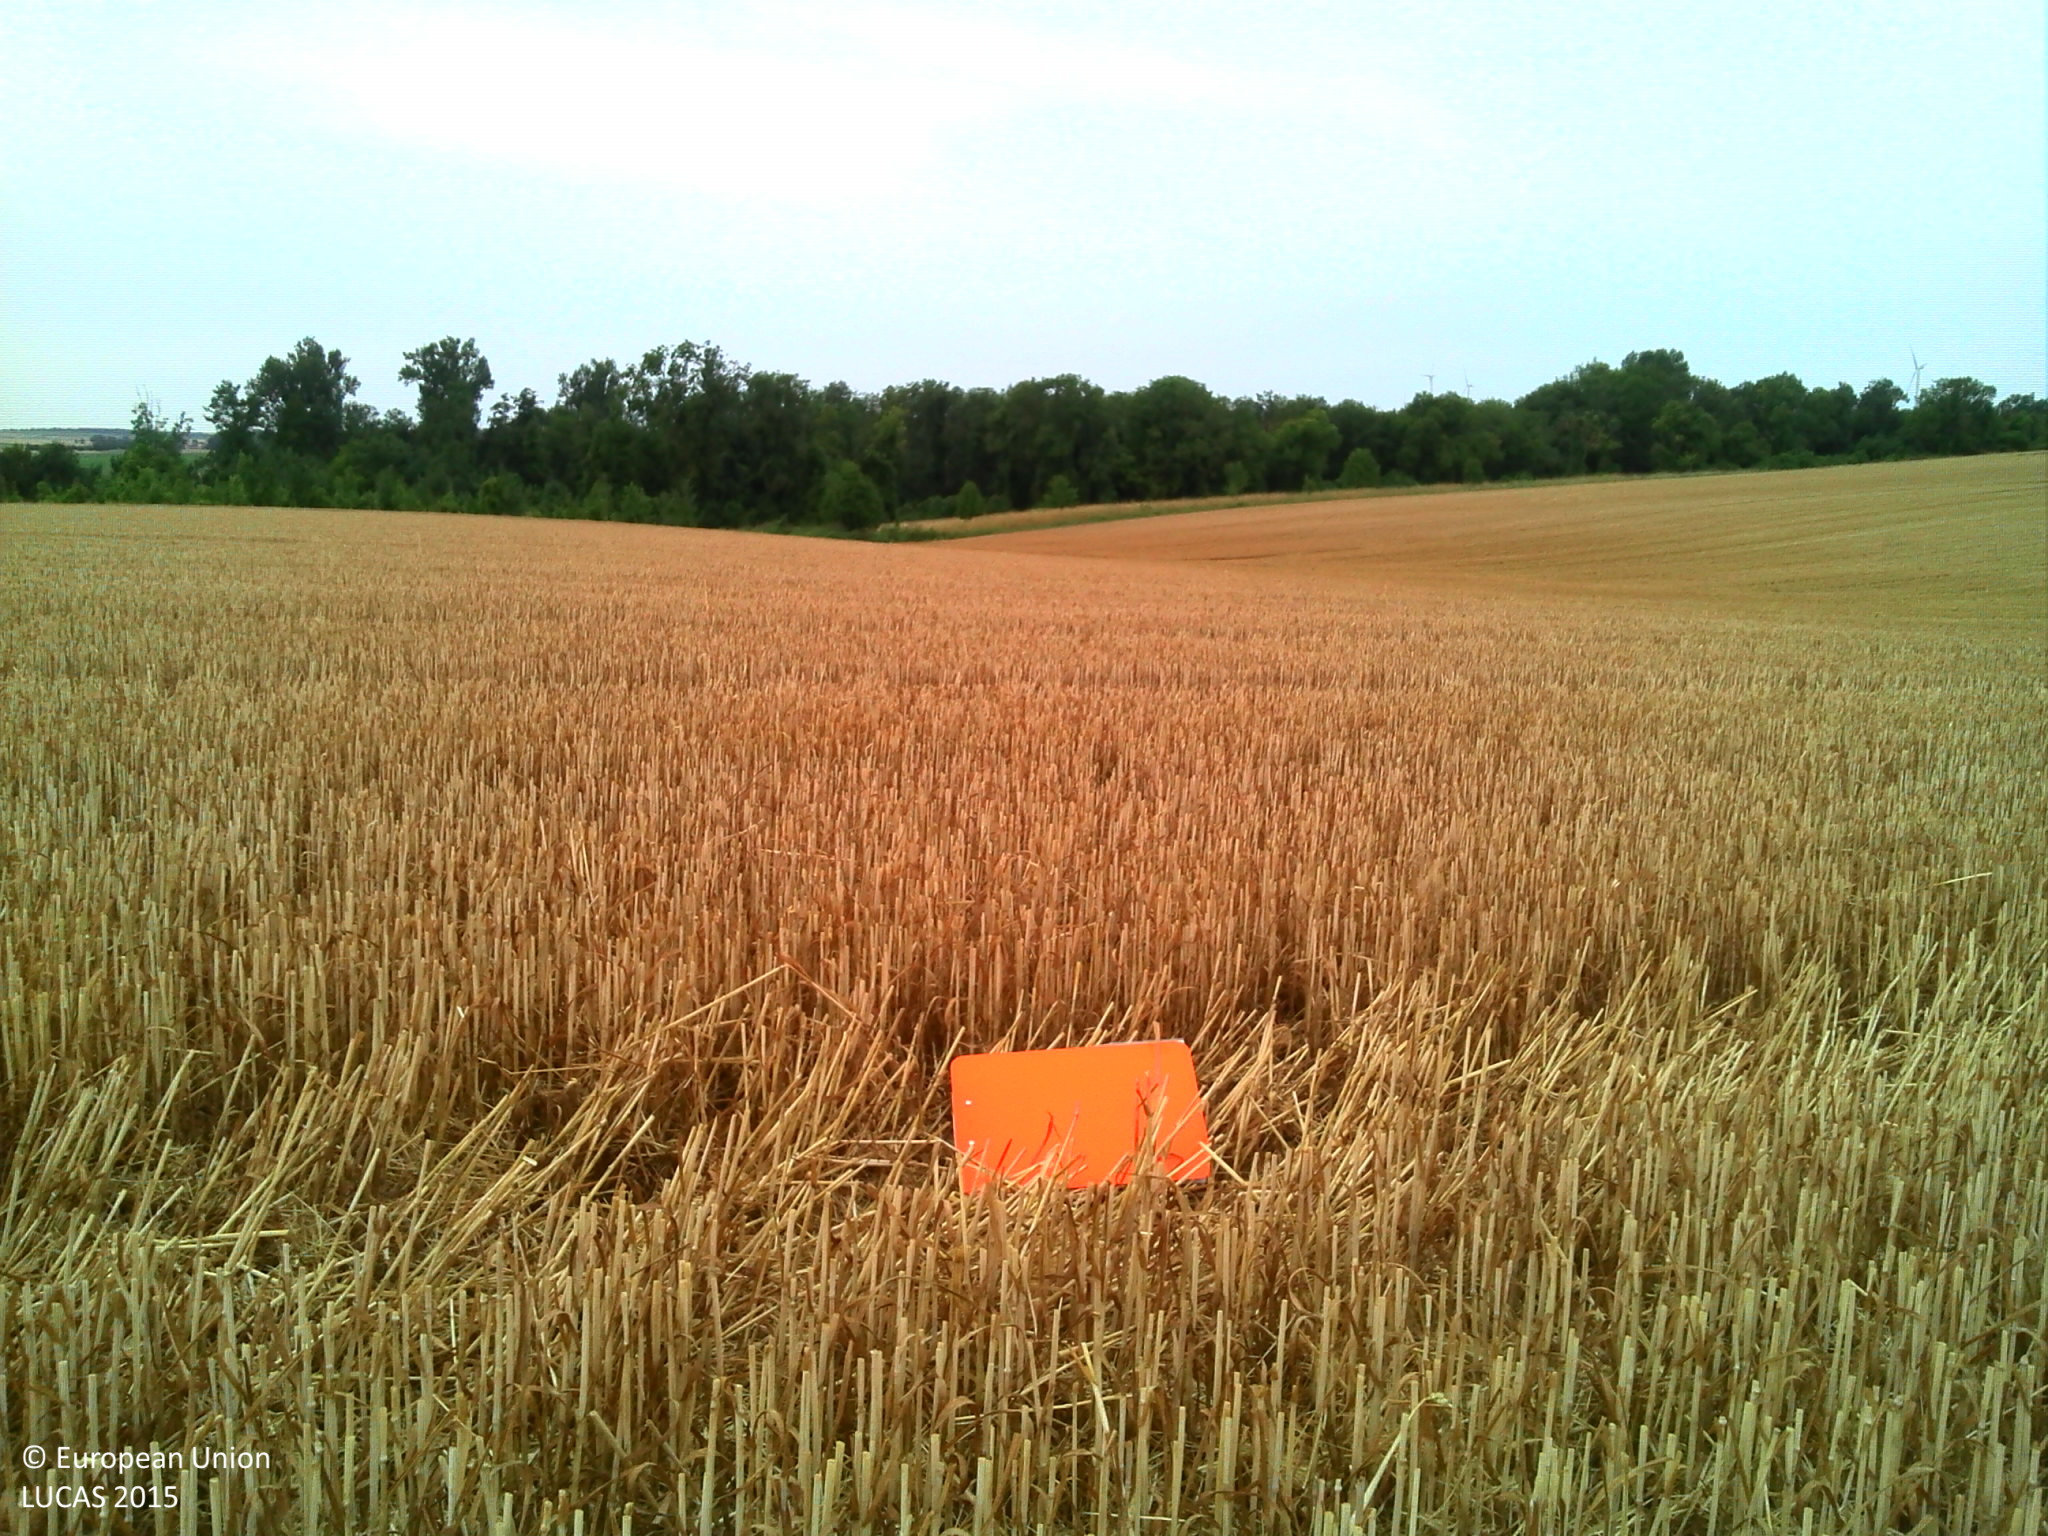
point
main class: Cropland
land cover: Common wheat
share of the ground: > 75 %
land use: Agriculture (excluding fallow land and kitchen gardens)
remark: Harvested field
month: July
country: FR
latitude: 48.8632
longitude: 4.1752
